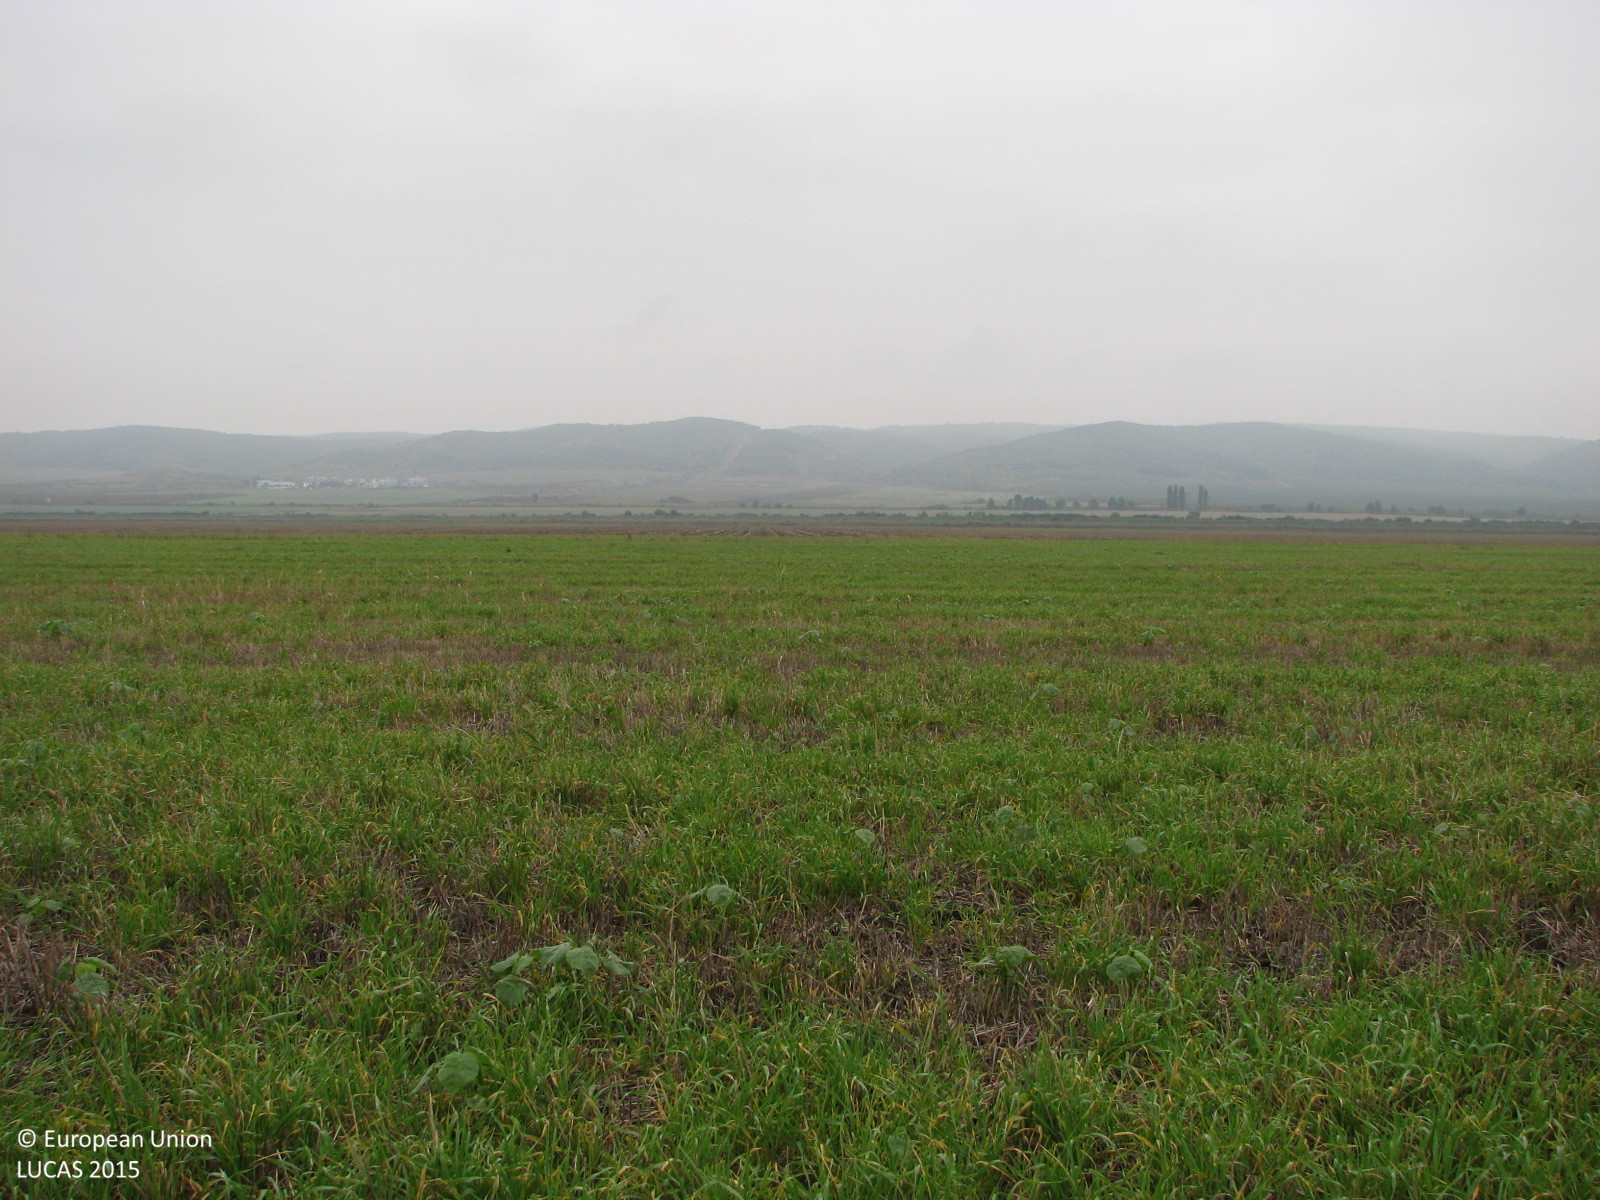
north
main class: Cropland
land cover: Common wheat
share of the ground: > 75 %
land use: Agriculture (excluding fallow land and kitchen gardens)
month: October
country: BG
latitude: 42.6287
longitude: 26.7441
